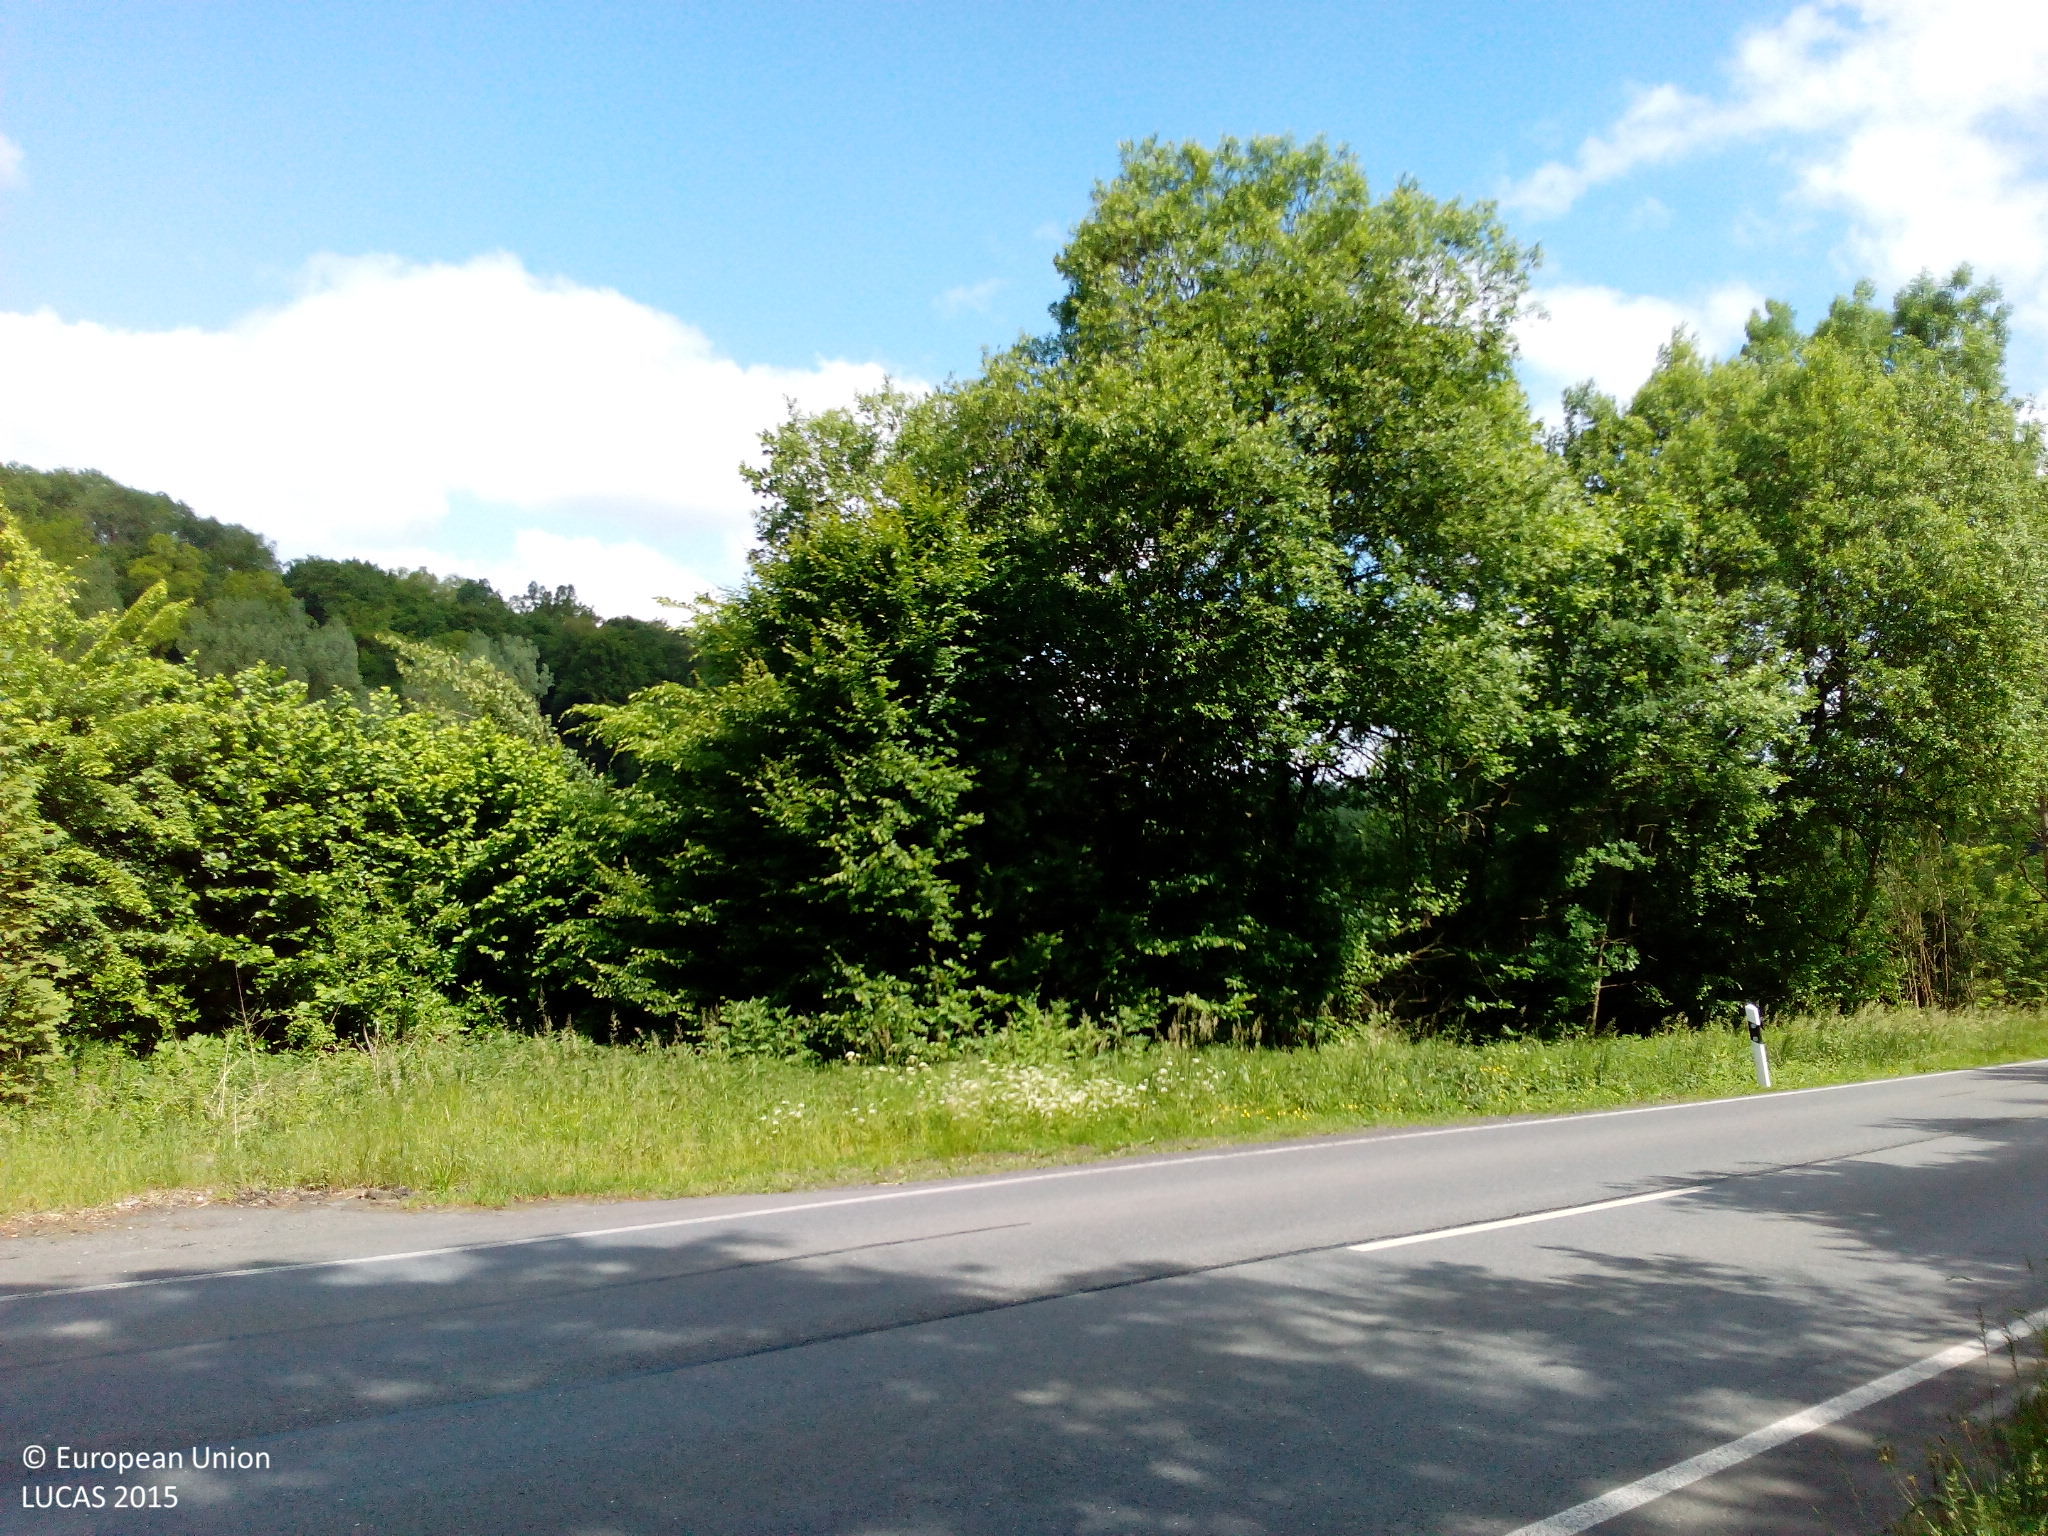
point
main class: Woodland
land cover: Broadleaved woodland
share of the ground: > 75 %
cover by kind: broadleaved forest trees 100 %
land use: Semi-natural and natural areas not in use
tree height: > 5 m
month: June
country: DE
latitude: 51.3897
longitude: 8.0028
